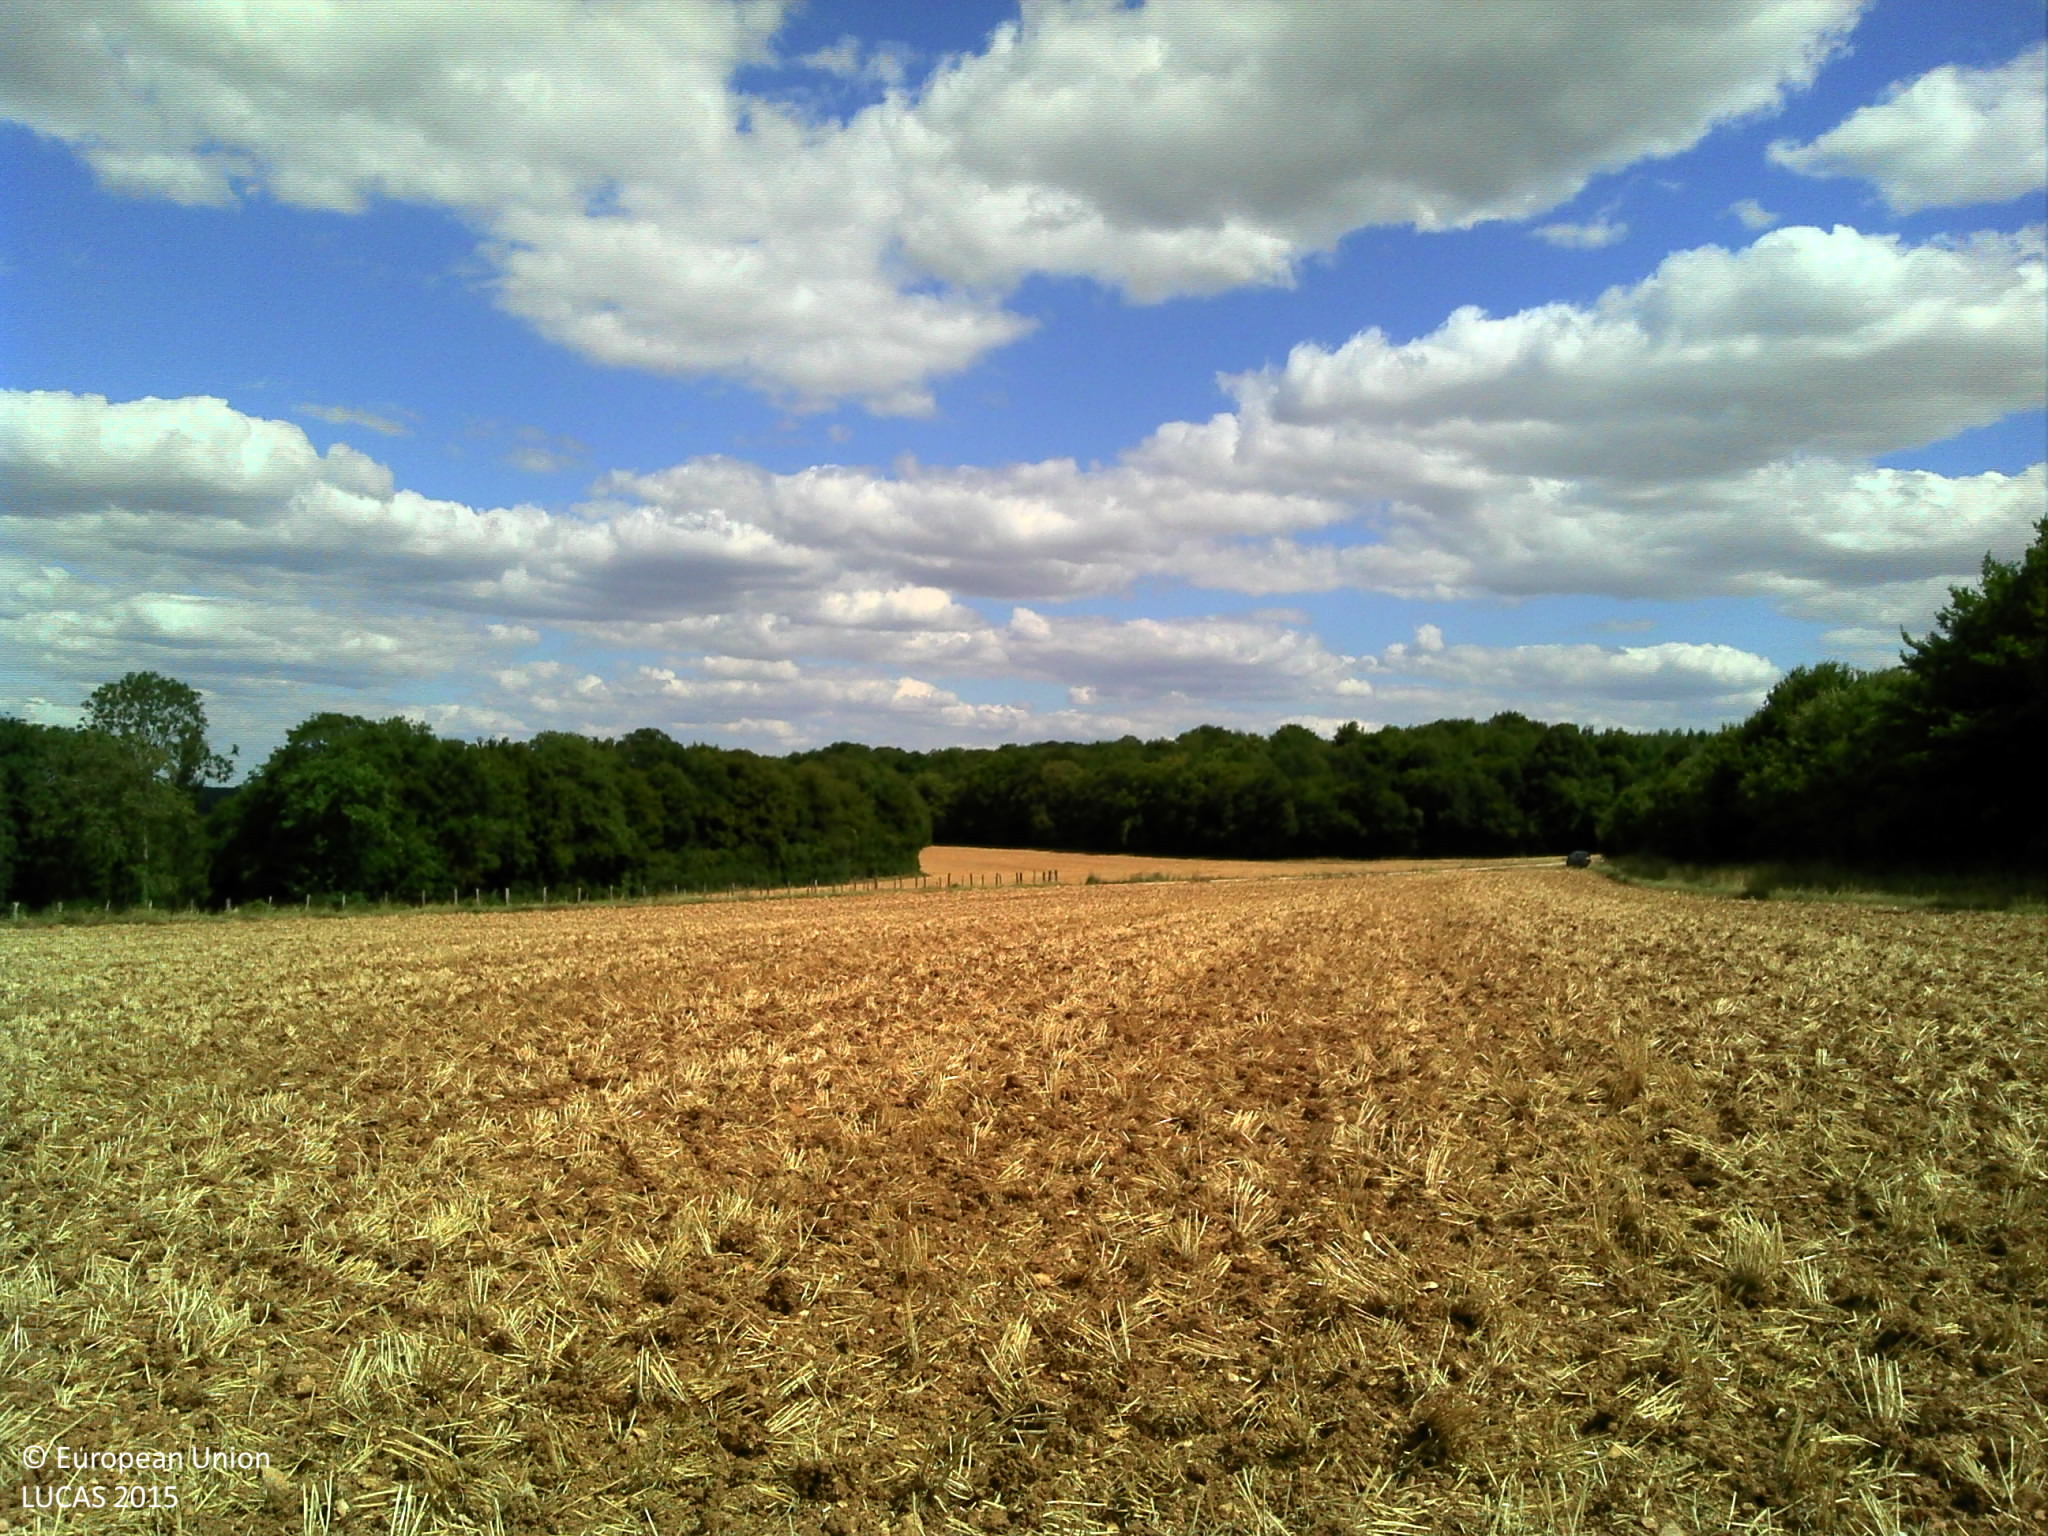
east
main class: Cropland
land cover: Common wheat
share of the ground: 10 - 25 %
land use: Agriculture (excluding fallow land and kitchen gardens)
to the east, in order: Common wheat; Grass margins; Tracks; Grass margins; Fences; Grassland without tree/shrub cover; Fences; Common wheat; Broadleaved woodland
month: July
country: FR
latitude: 47.6680
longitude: 5.1924
